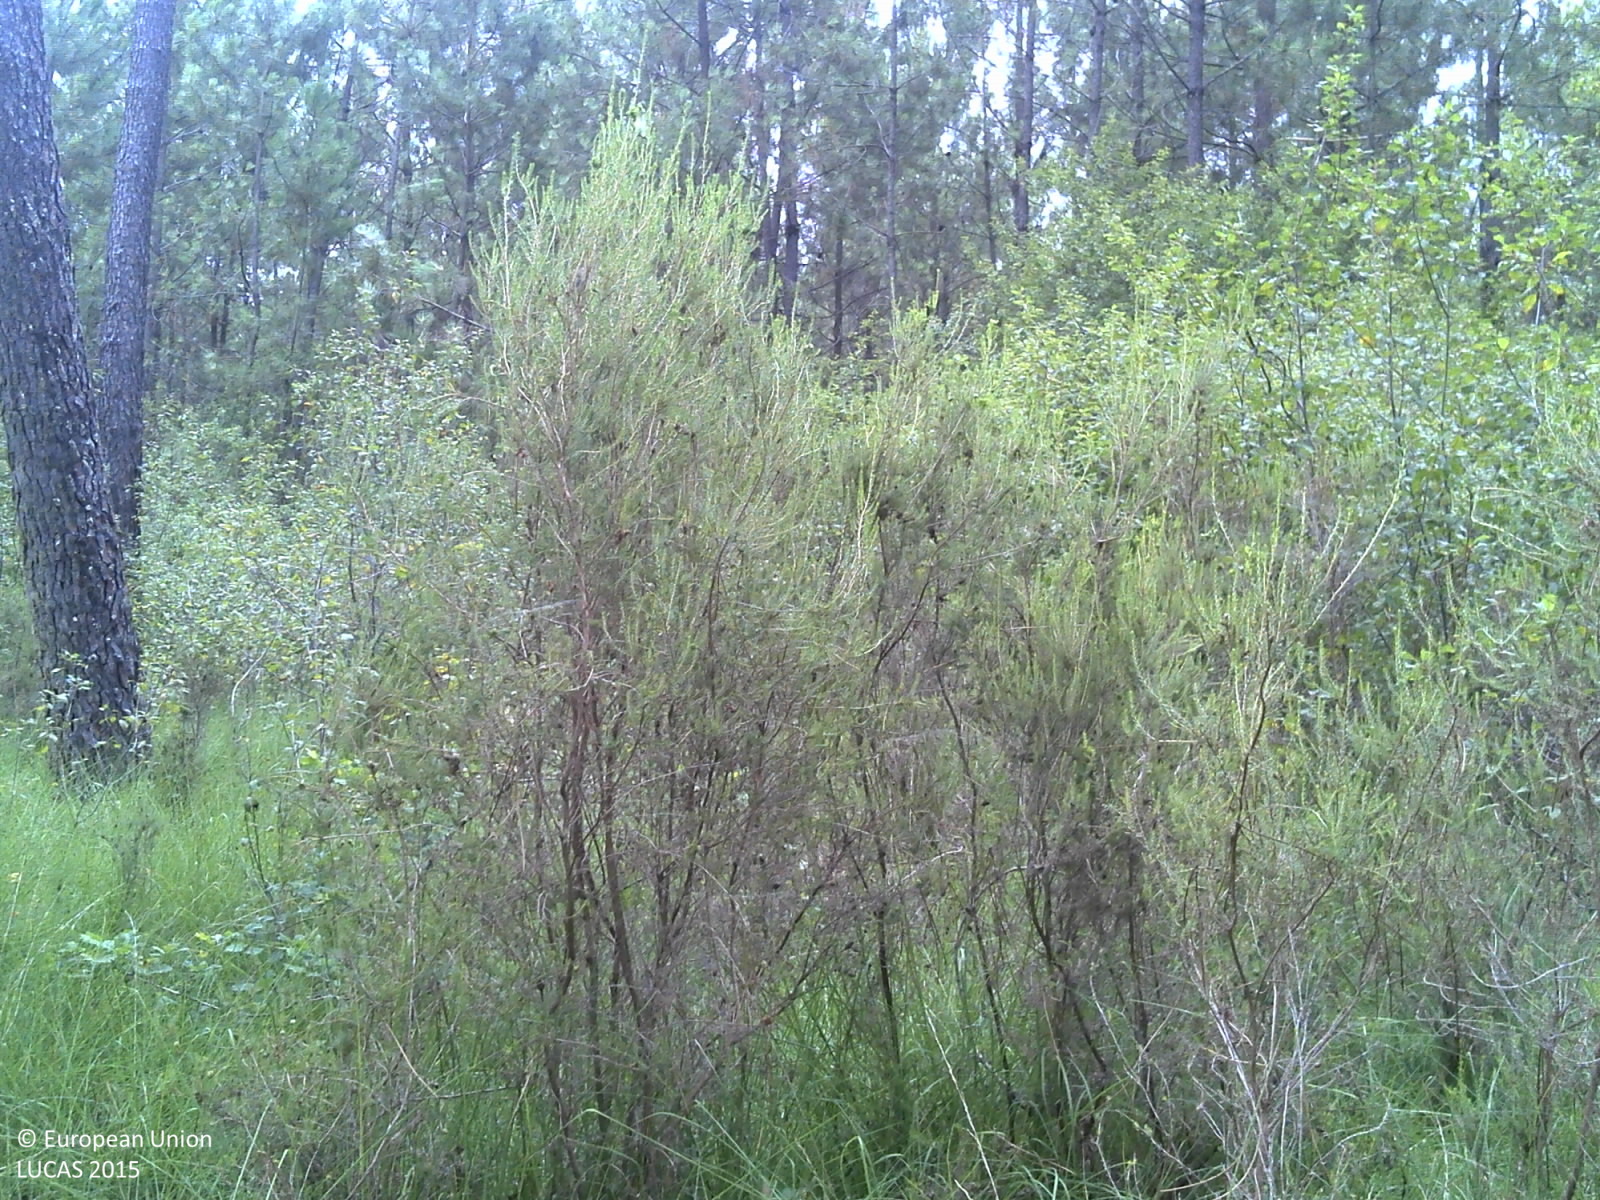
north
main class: Woodland
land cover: Pine dominated coniferous woodland
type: floodplain forest
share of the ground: > 75 %
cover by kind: coniferous forest trees 60 %, shrubs 30 %, herbaceous plants 5 %, lichens and mosses 5 %
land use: Forestry
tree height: > 5 m
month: July
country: FR
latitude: 44.2883
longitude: -0.3265
